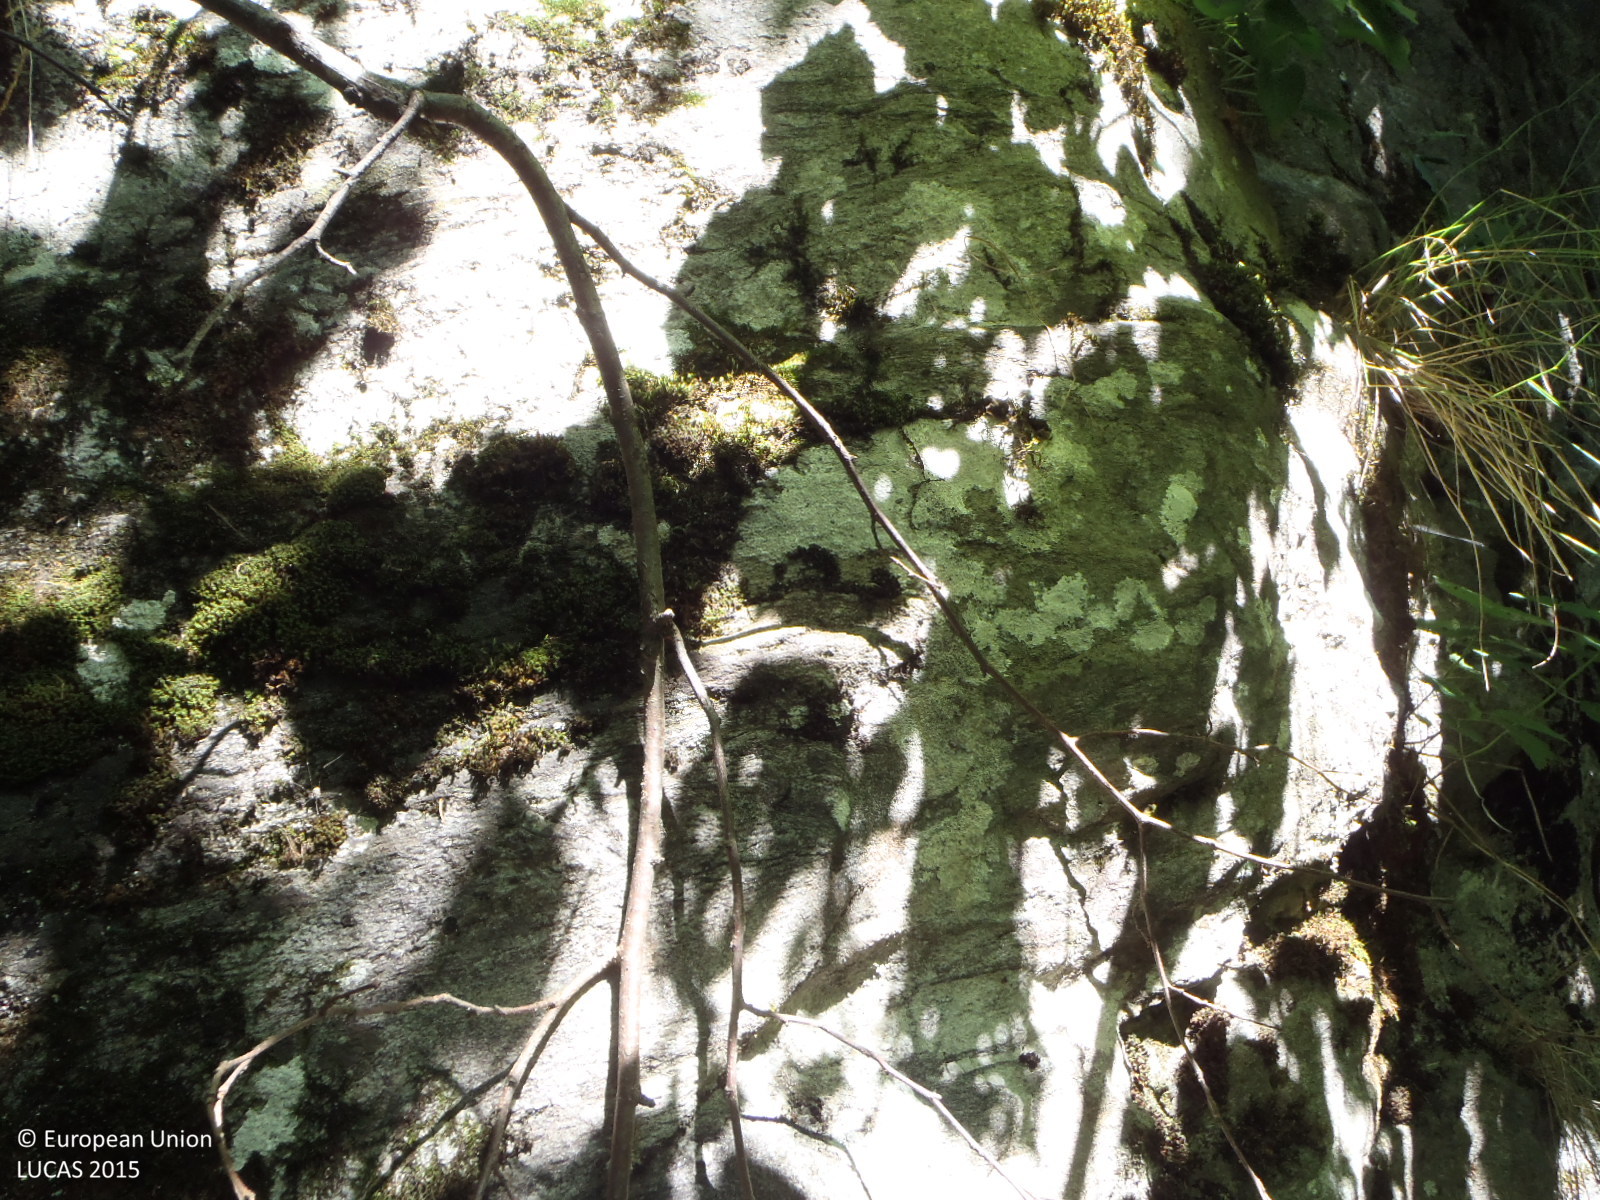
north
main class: Woodland
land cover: Broadleaved woodland
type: mountainous beech forest
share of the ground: > 75 %
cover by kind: broadleaved forest trees 75 %, coniferous forest trees 15 %, herbaceous plants 5 %, consolidated bare surface 5 %
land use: Forestry
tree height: > 5 m
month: July
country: AT
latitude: 47.0930
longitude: 11.7768
